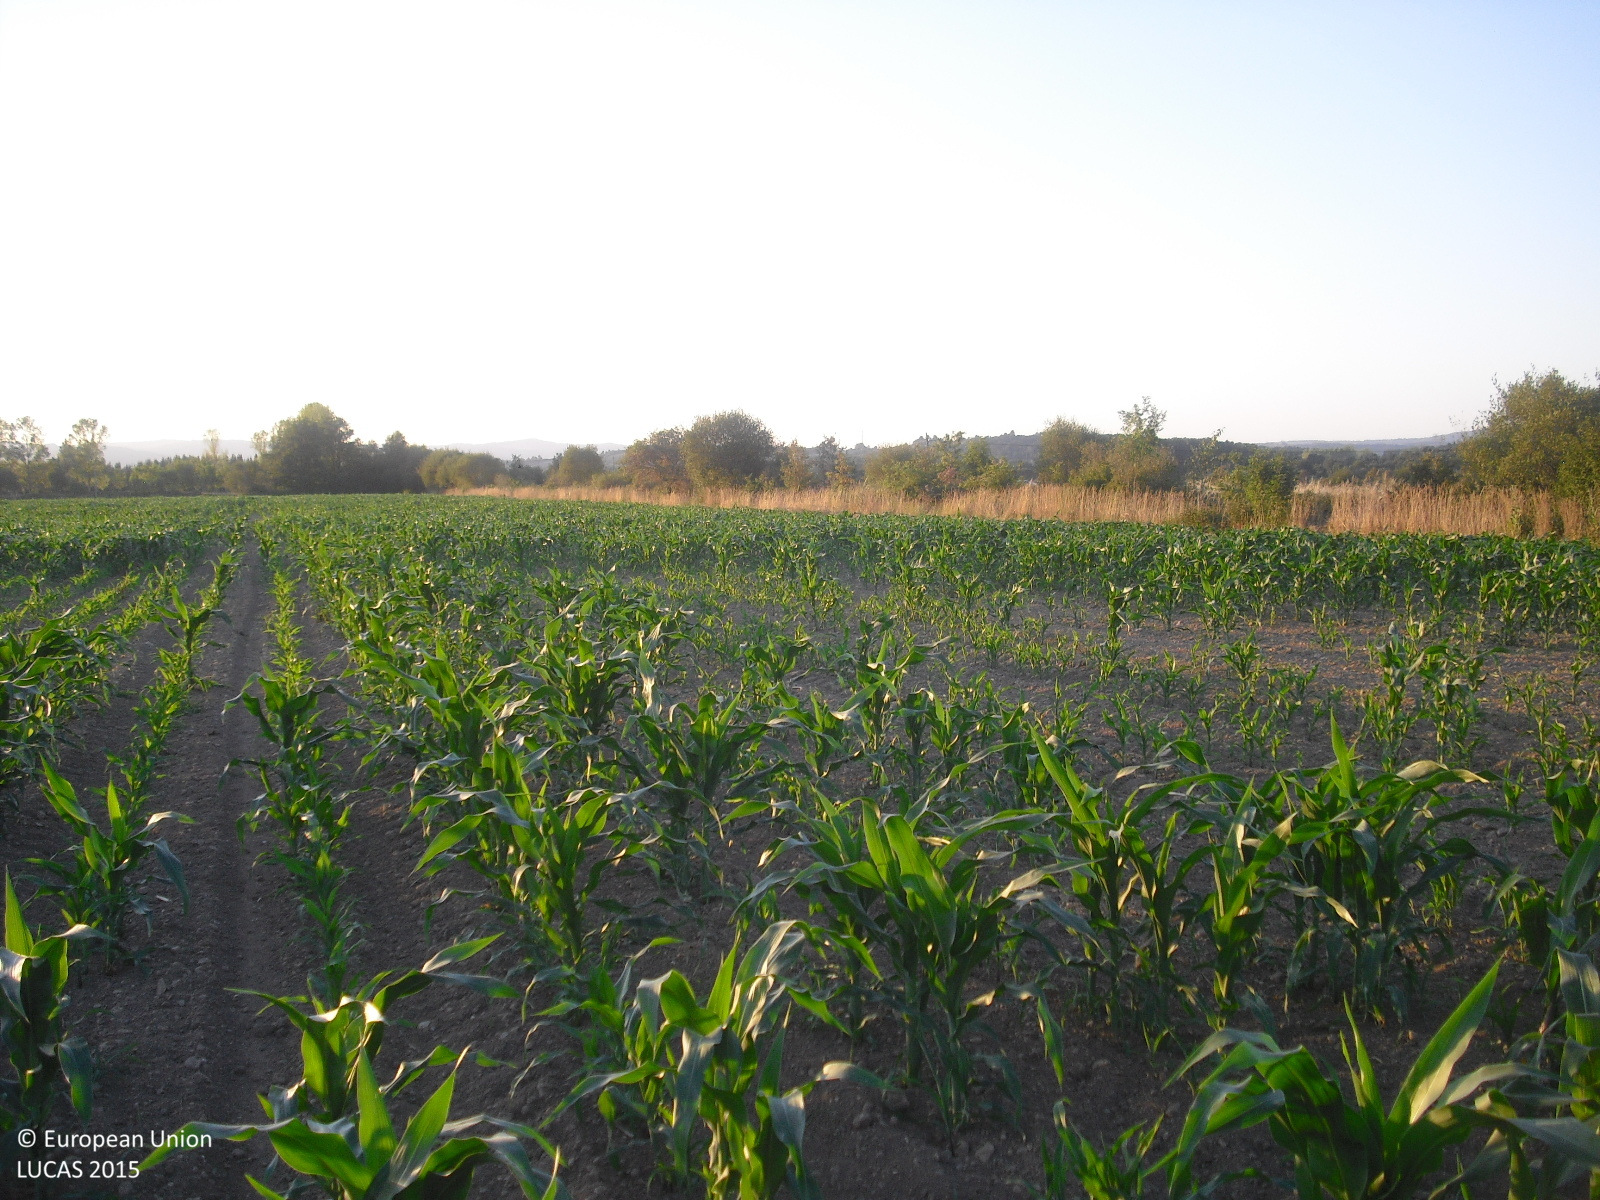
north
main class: Cropland
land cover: Maize
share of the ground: > 75 %
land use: Agriculture (excluding fallow land and kitchen gardens)
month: July
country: ES
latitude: 42.5980
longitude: -7.4610
